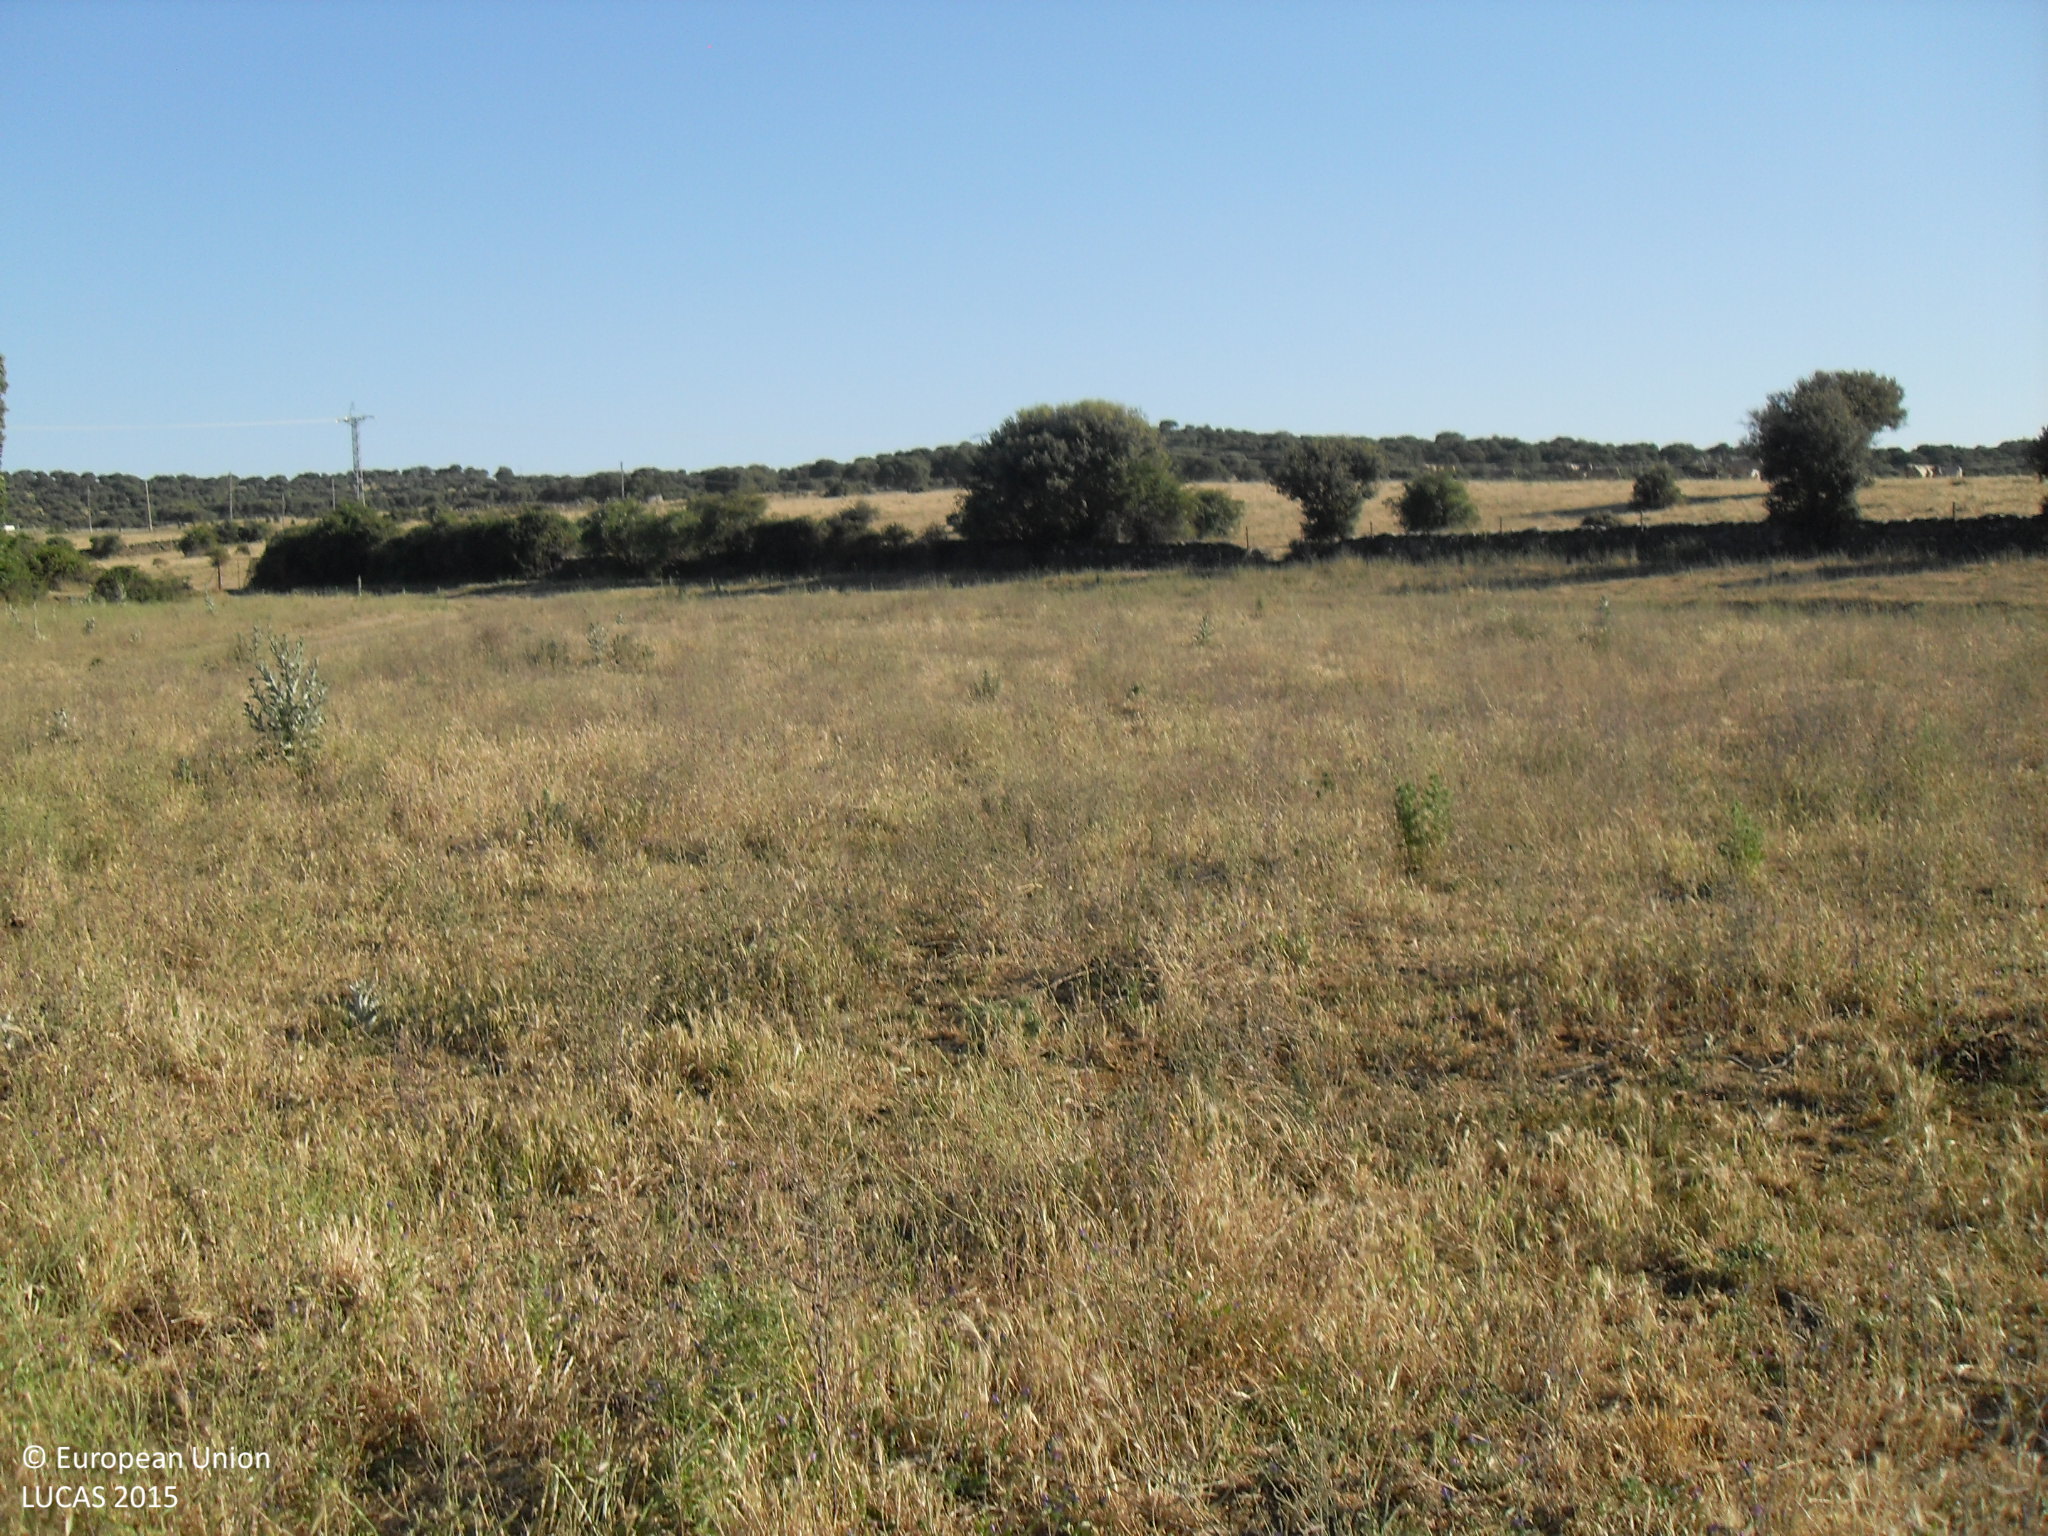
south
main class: Grassland
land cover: Grassland without tree/shrub cover
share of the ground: > 75 %
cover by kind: herbaceous plants 100 %
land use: Agriculture (excluding fallow land and kitchen gardens)
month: June
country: ES
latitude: 40.5801
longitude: -5.5575
